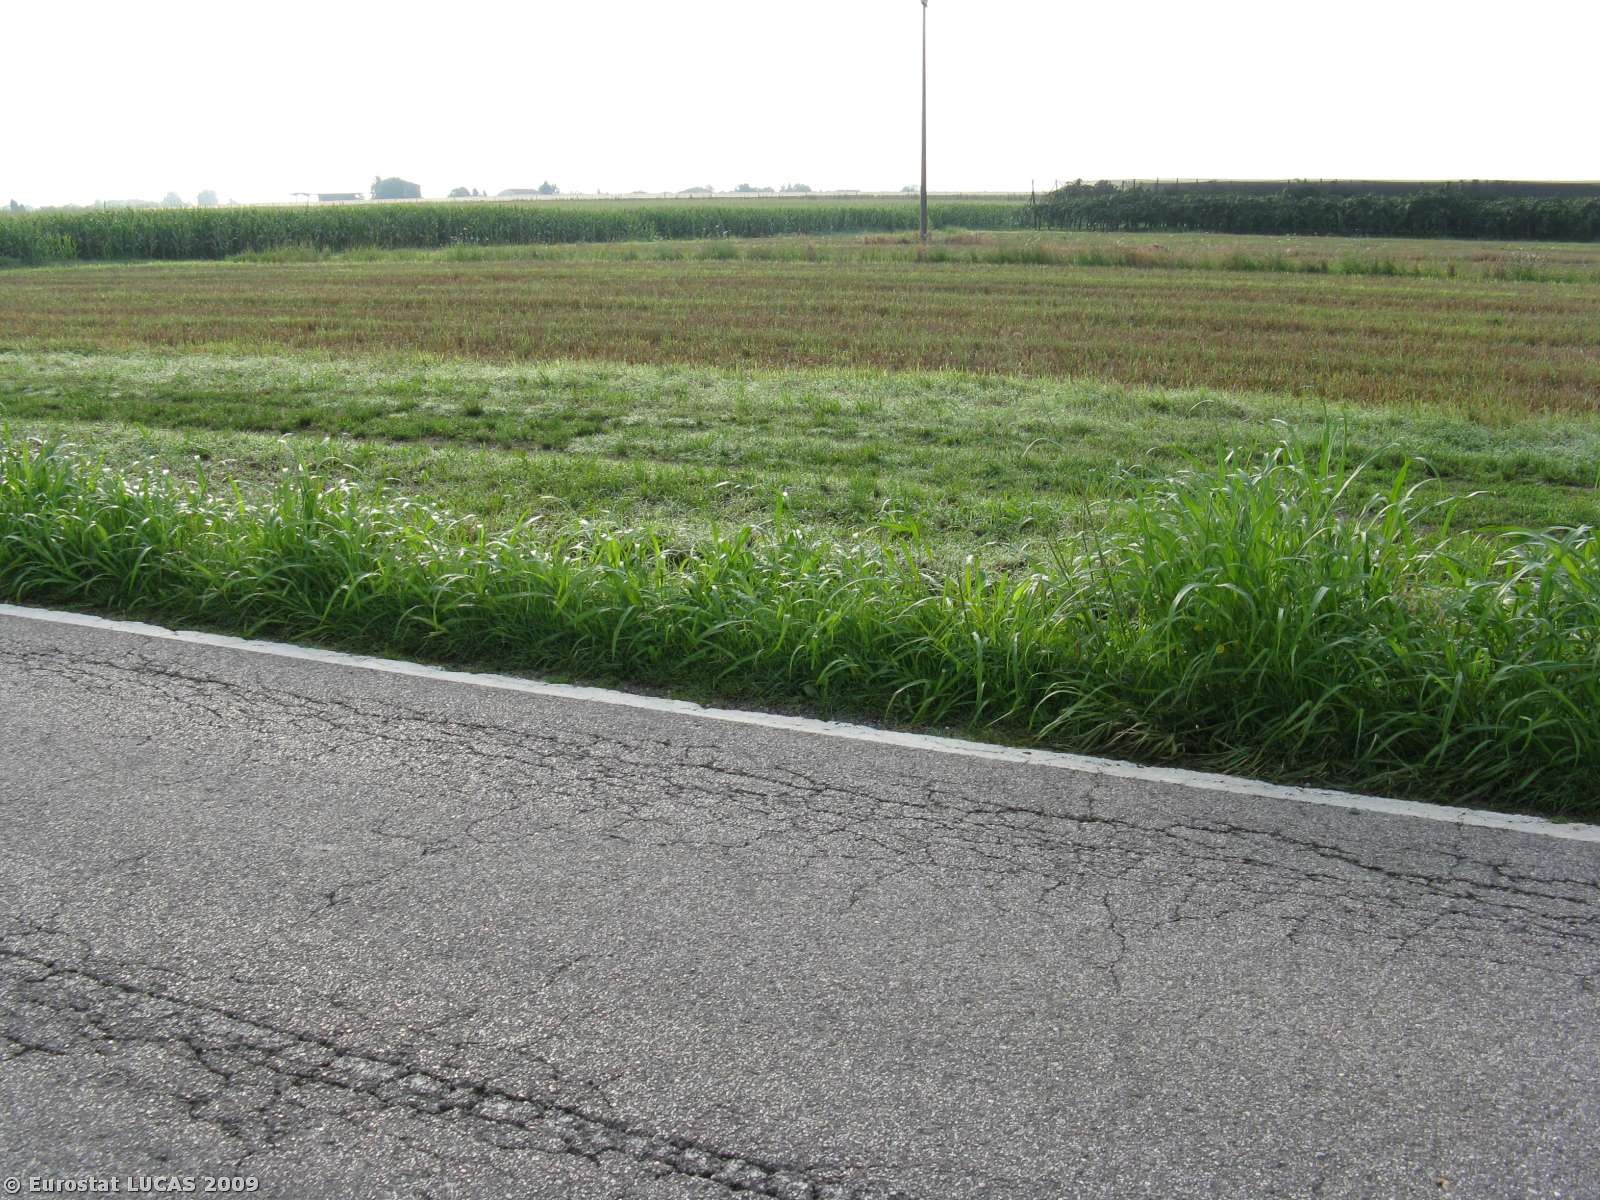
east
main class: Cropland
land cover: Maize
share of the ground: > 75 %
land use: Agriculture (excluding fallow land and kitchen gardens)
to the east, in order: Maize; Ditches and canals; Electric lines; Artificial constructions in urban areas; Ditches and canals; Tracks; Maize
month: July
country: IT
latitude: 44.7330
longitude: 11.7265
